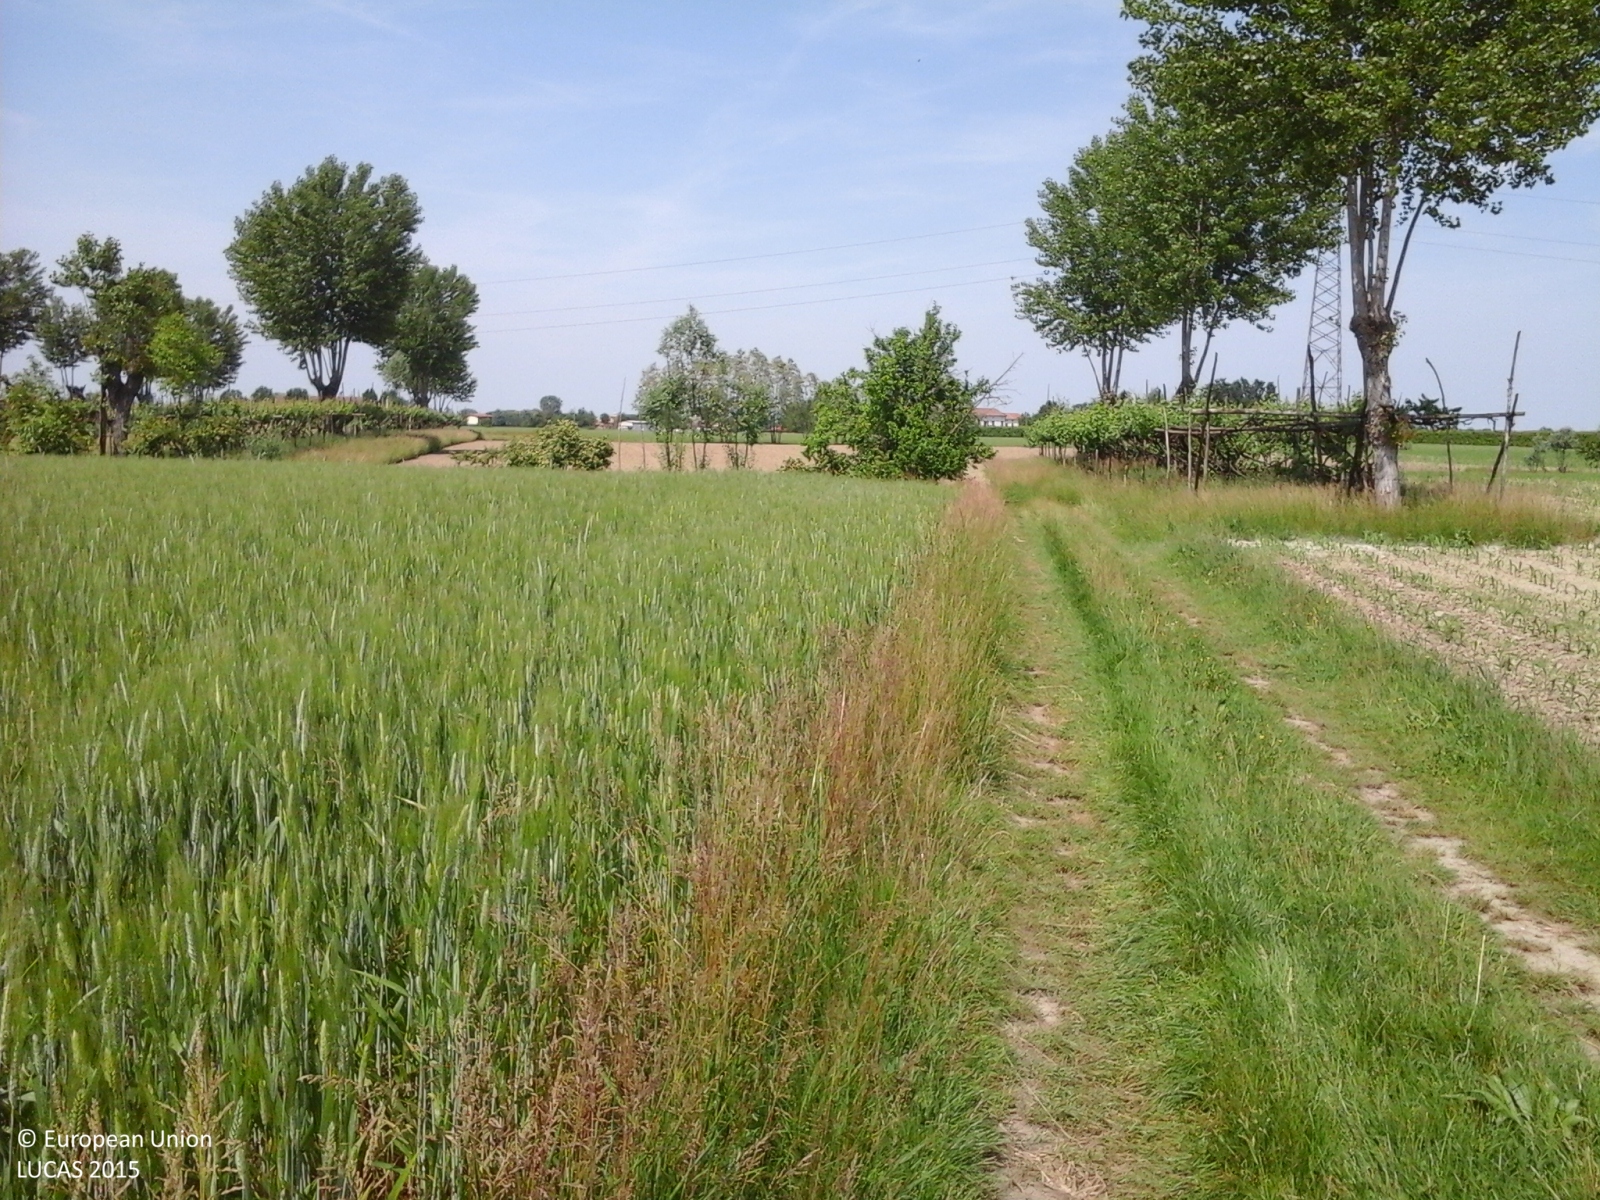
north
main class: Cropland
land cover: Common wheat
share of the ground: > 75 %
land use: Agriculture (excluding fallow land and kitchen gardens)
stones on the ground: < 10 %
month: May
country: IT
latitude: 44.9441
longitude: 10.5692
